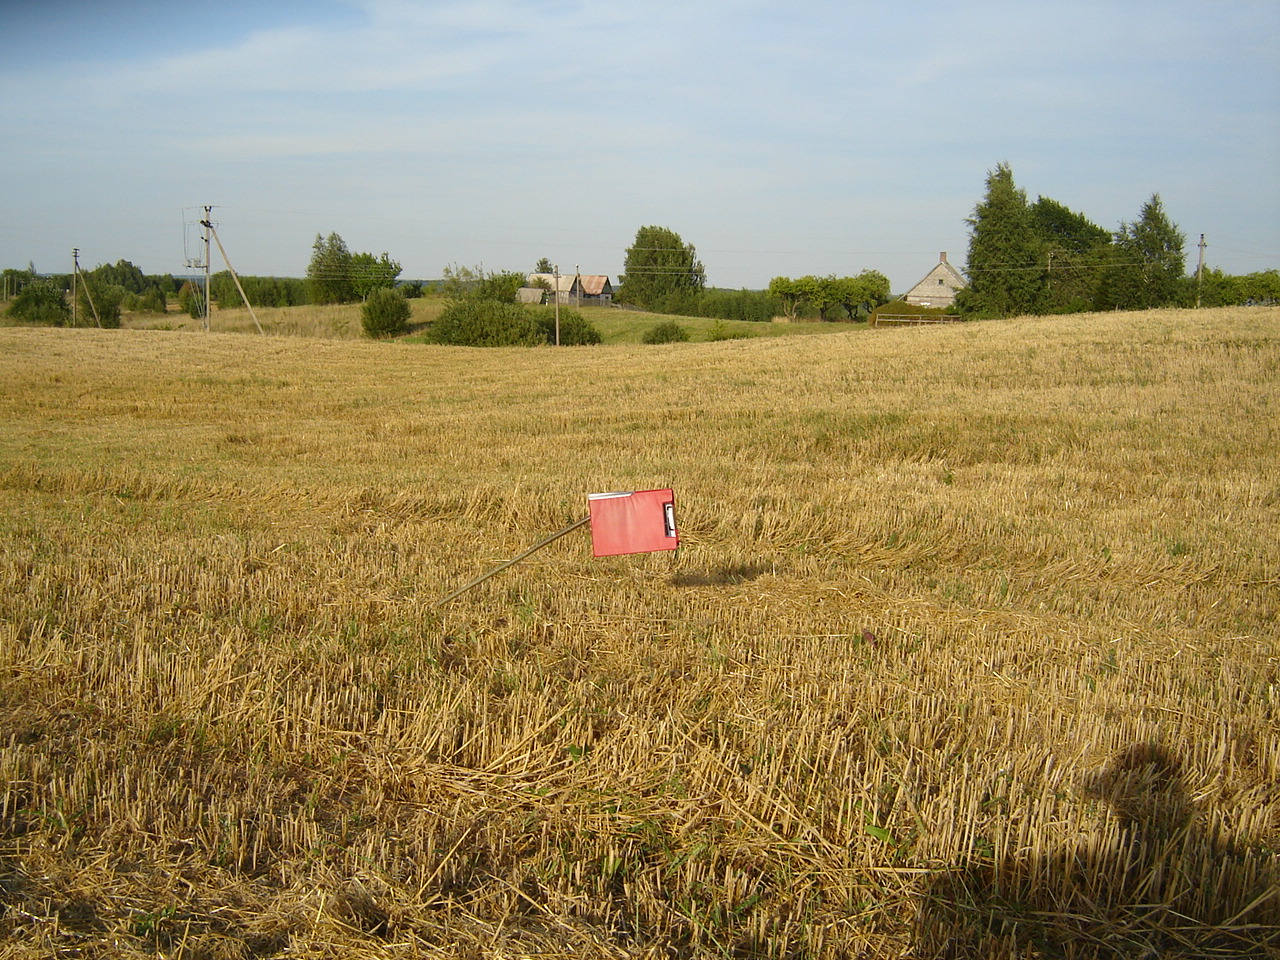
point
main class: Cropland
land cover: Barley
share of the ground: > 75 %
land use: Agriculture (excluding fallow land and kitchen gardens)
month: August
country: LT
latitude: 54.7134
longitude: 24.8412
